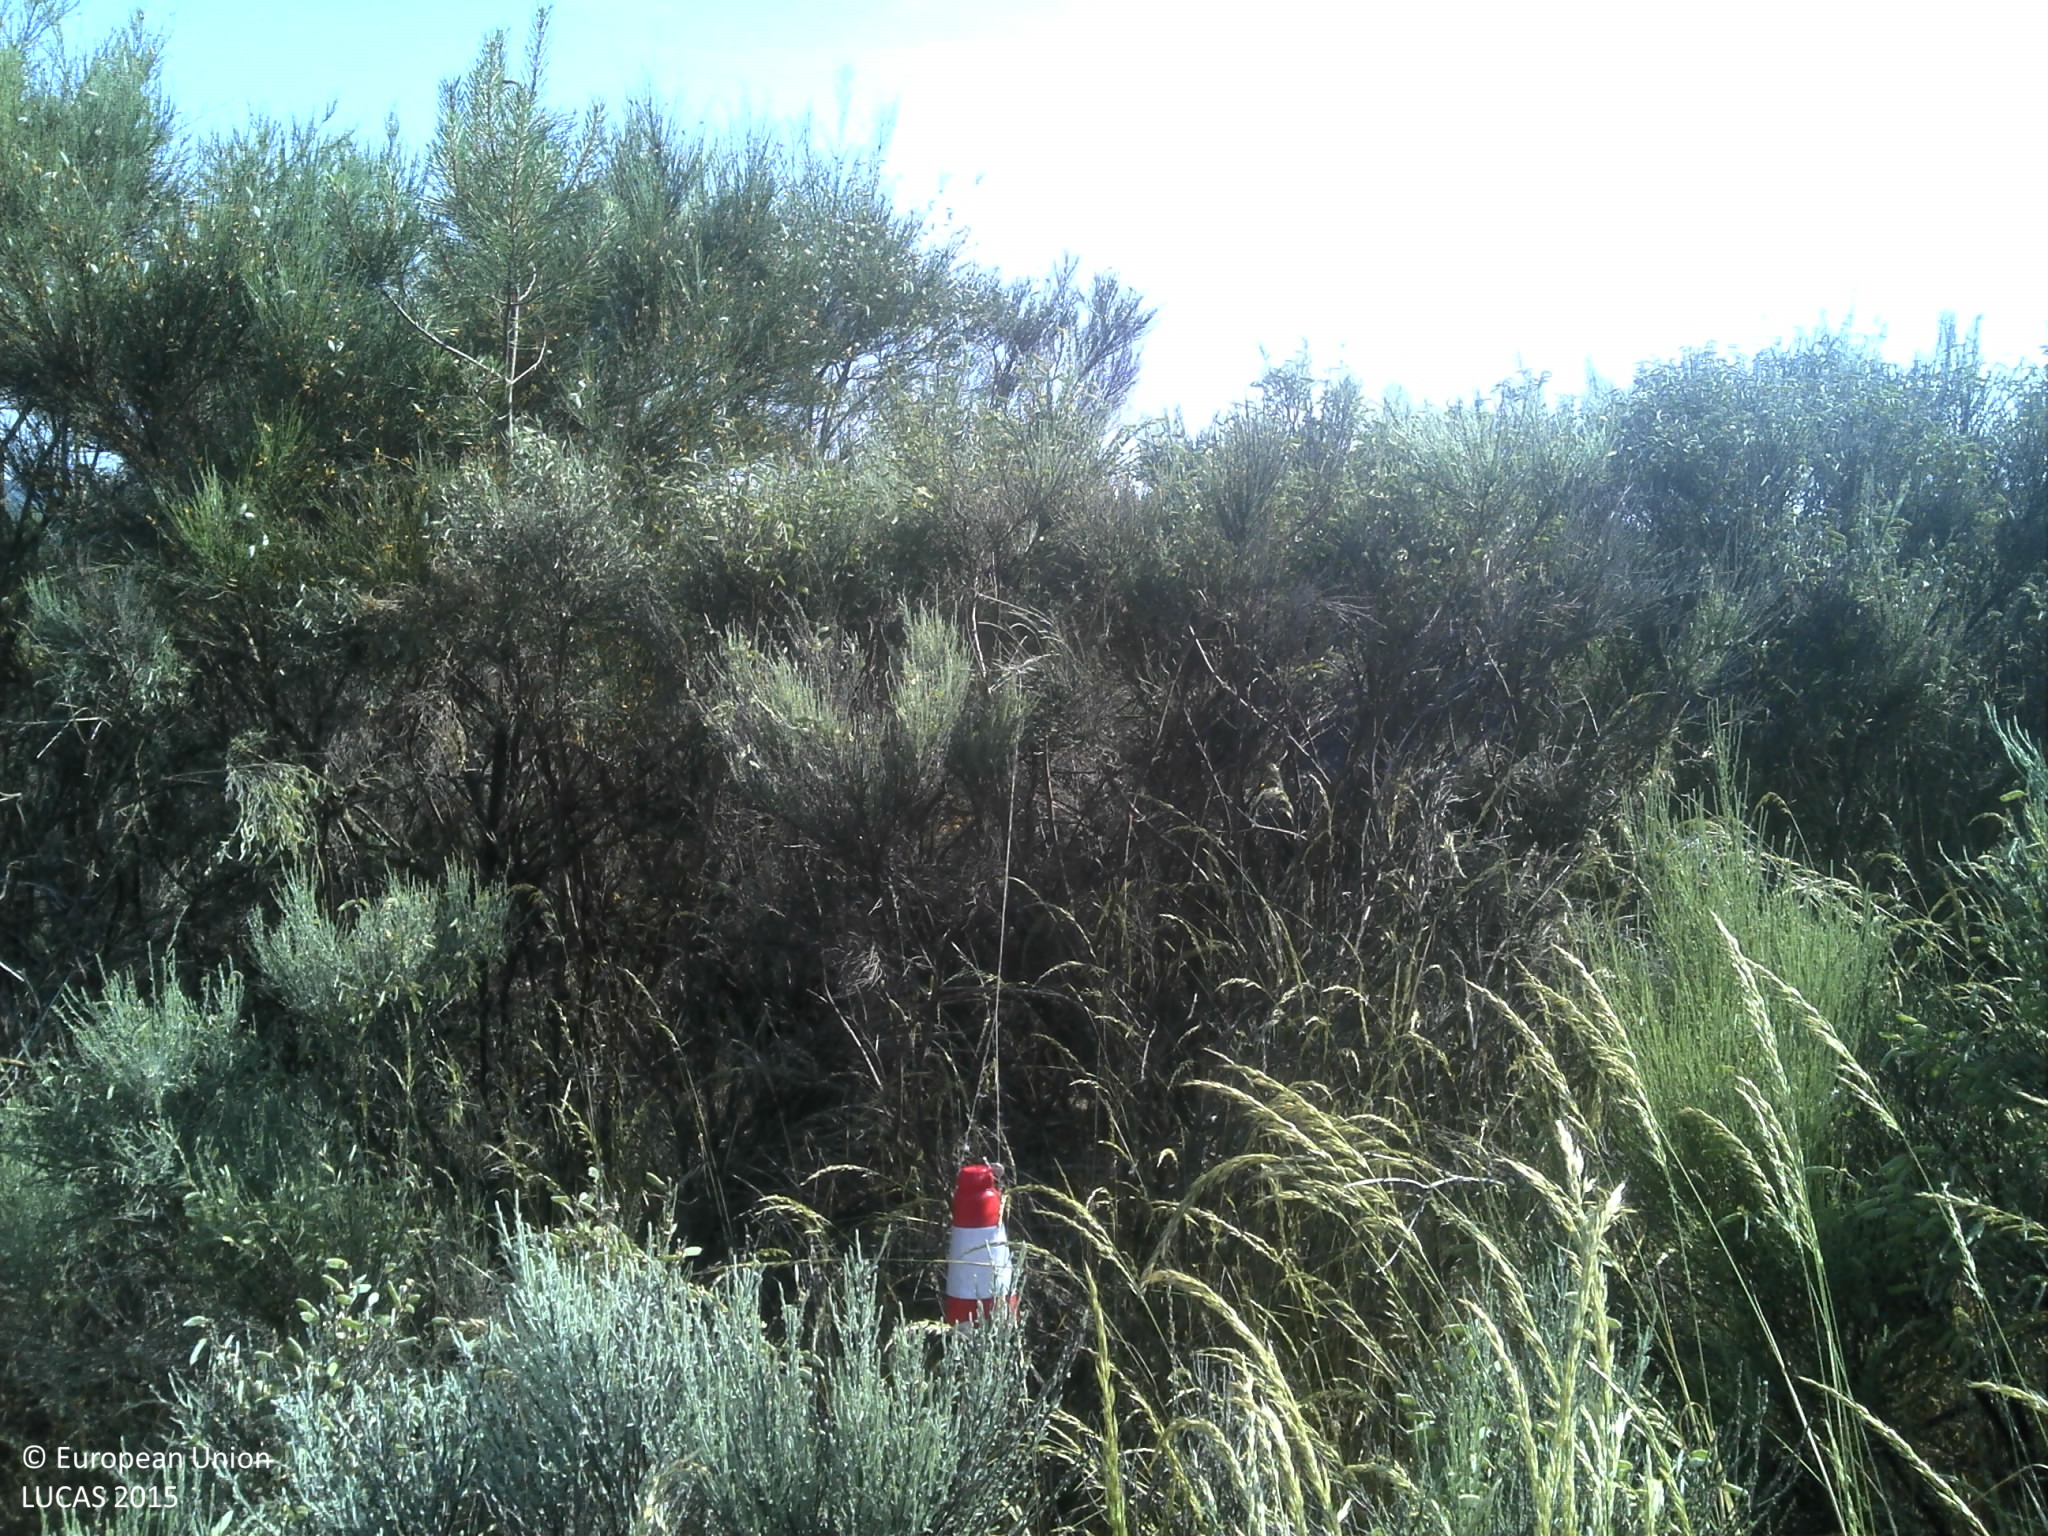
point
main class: Shrubland
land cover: Shrubland with sparse tree cover
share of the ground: 50 - 75 %
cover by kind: shrubs 75 %, unconsolidated bare surface 15 %, broadleaved forest trees 5 %, herbaceous plants 5 %
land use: Semi-natural and natural areas not in use
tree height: < 5 m
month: June
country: PT
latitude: 40.4001
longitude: -7.1739
